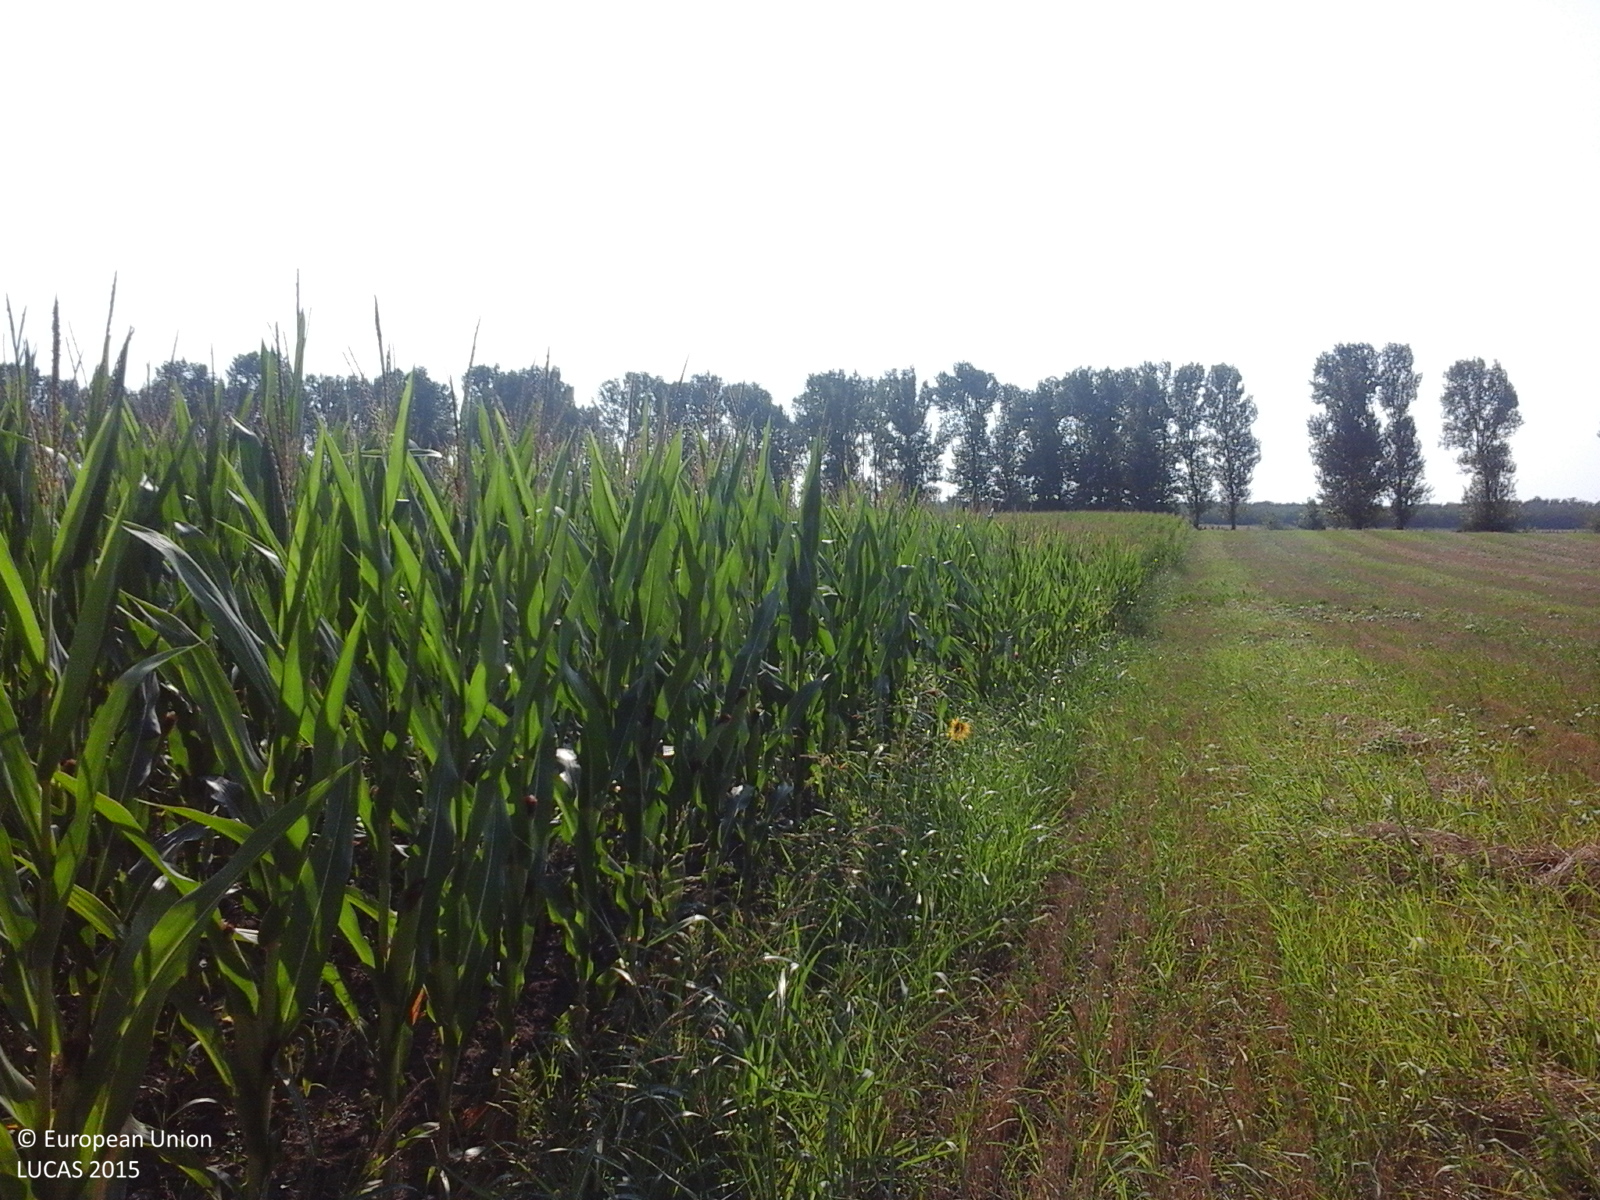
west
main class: Cropland
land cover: Maize
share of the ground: > 75 %
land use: Agriculture (excluding fallow land and kitchen gardens)
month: July
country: RO
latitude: 44.8943
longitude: 27.1690
